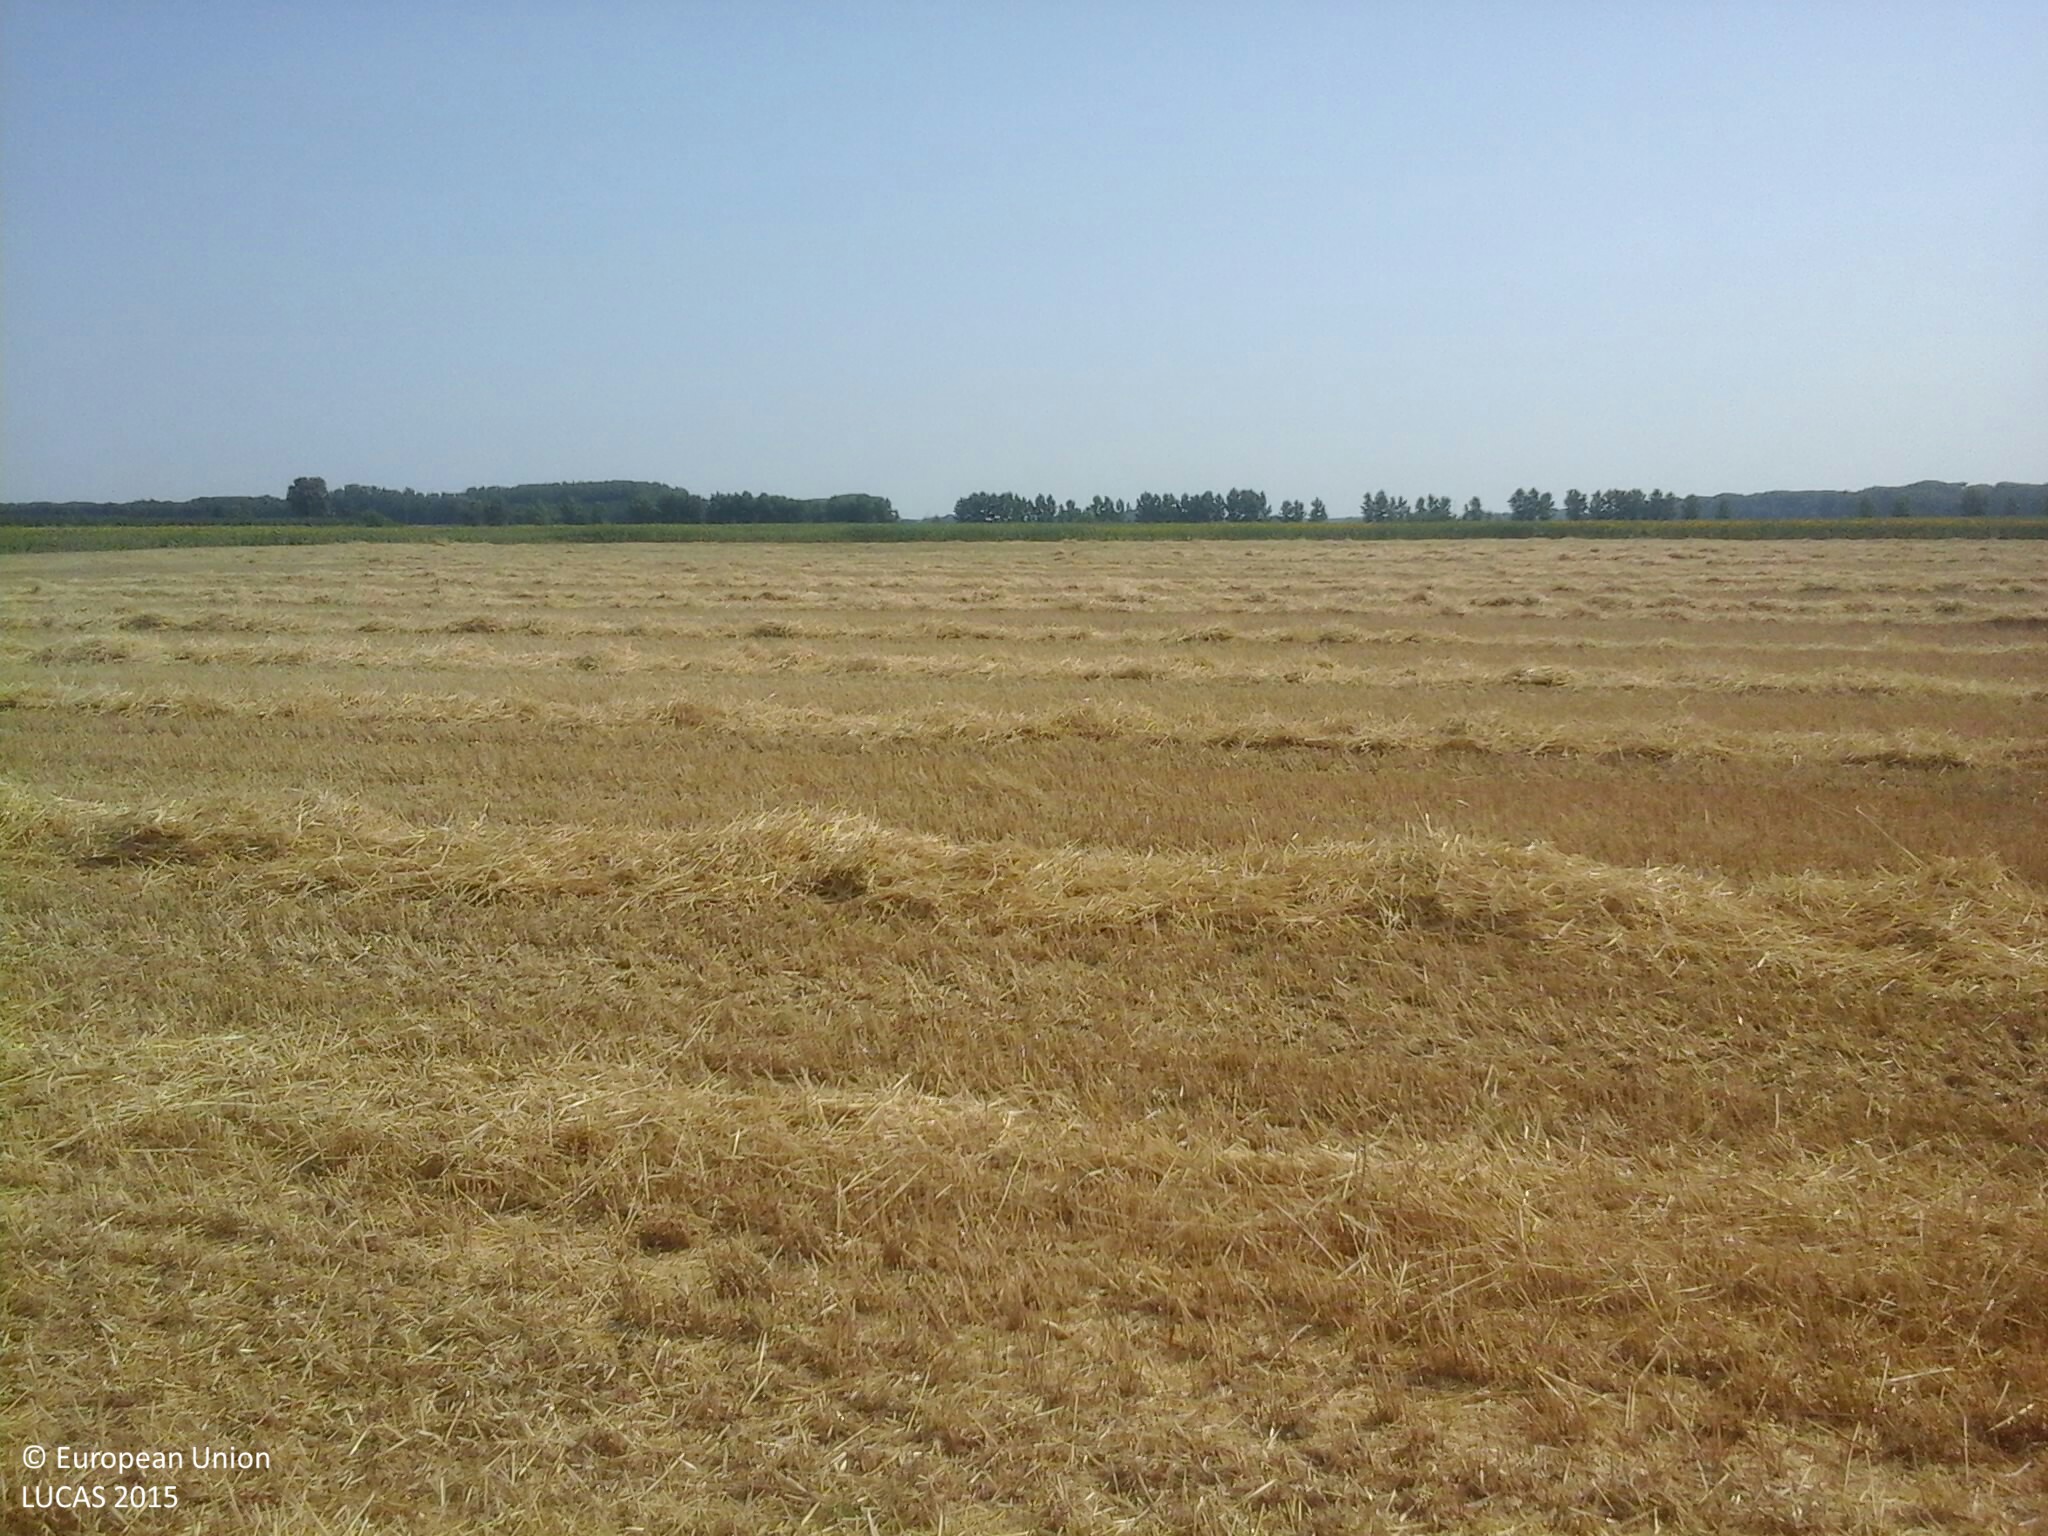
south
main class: Cropland
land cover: Common wheat
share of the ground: > 75 %
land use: Agriculture (excluding fallow land and kitchen gardens)
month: July
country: HU
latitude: 47.2225
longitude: 18.9831
